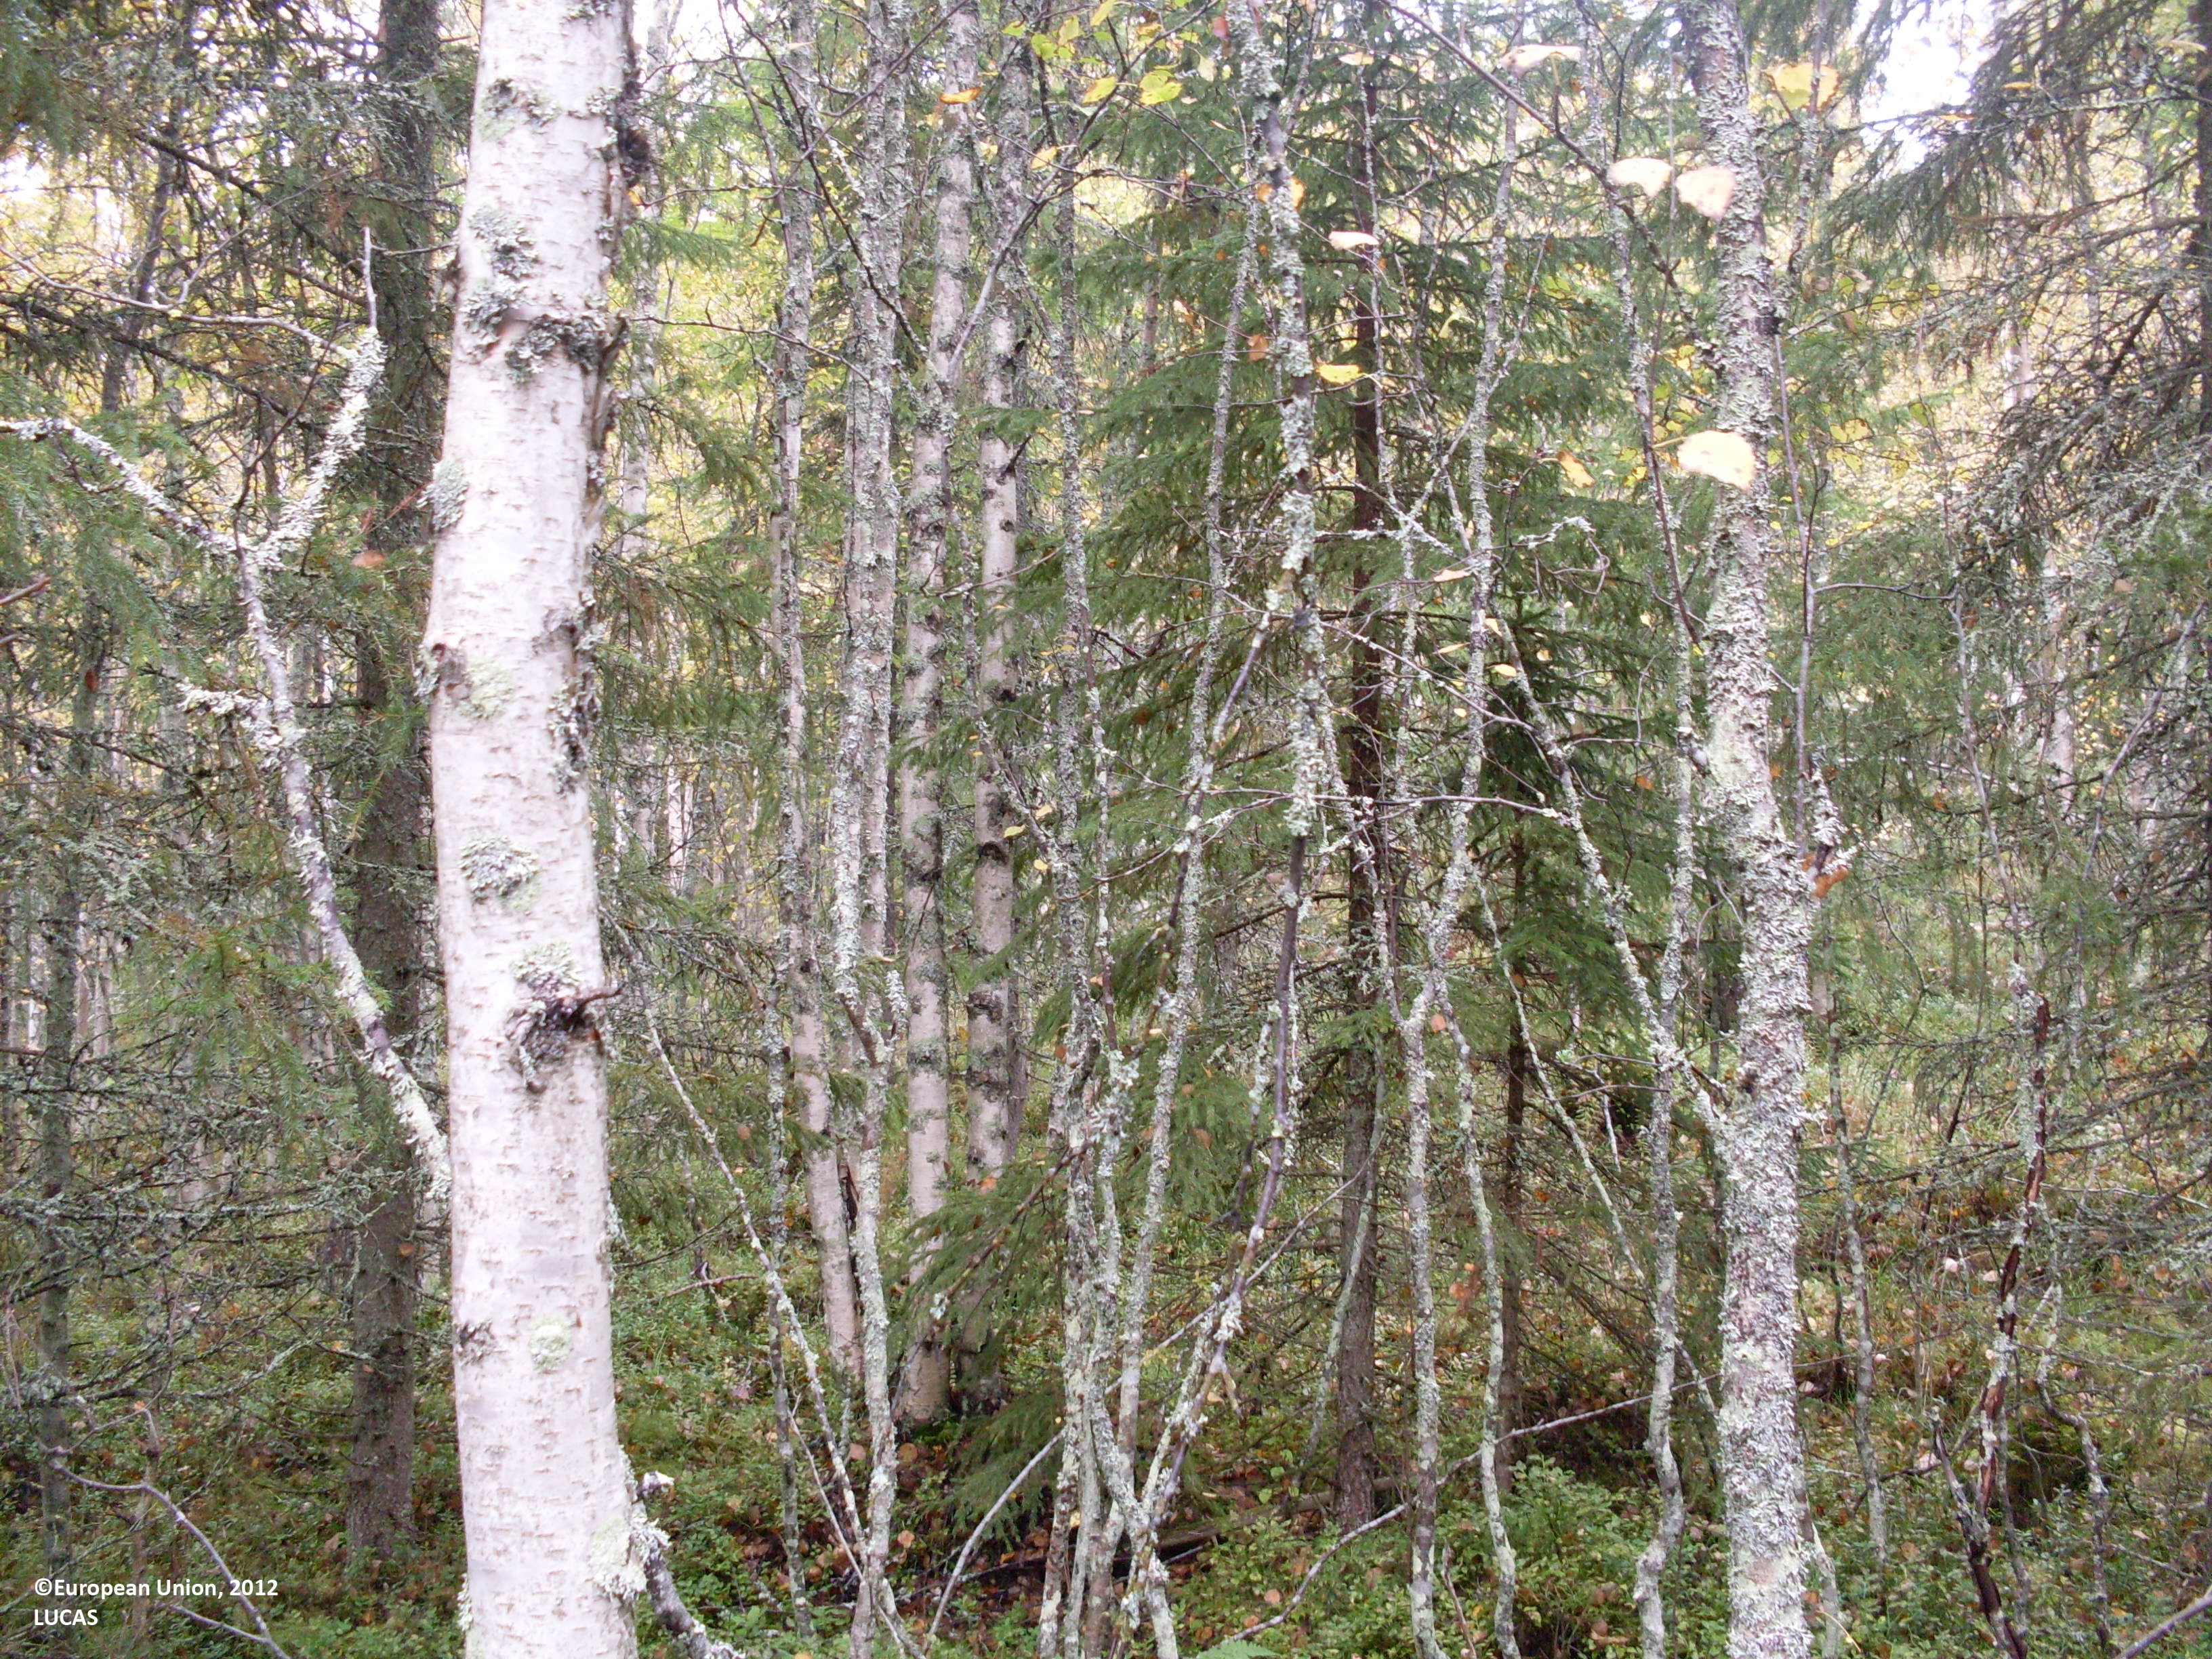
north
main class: Woodland
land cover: Spruce dominated mixed woodland
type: boreal forest
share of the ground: > 75 %
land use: Forestry
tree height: > 5 m
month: September
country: FI
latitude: 64.2140
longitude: 30.2550
